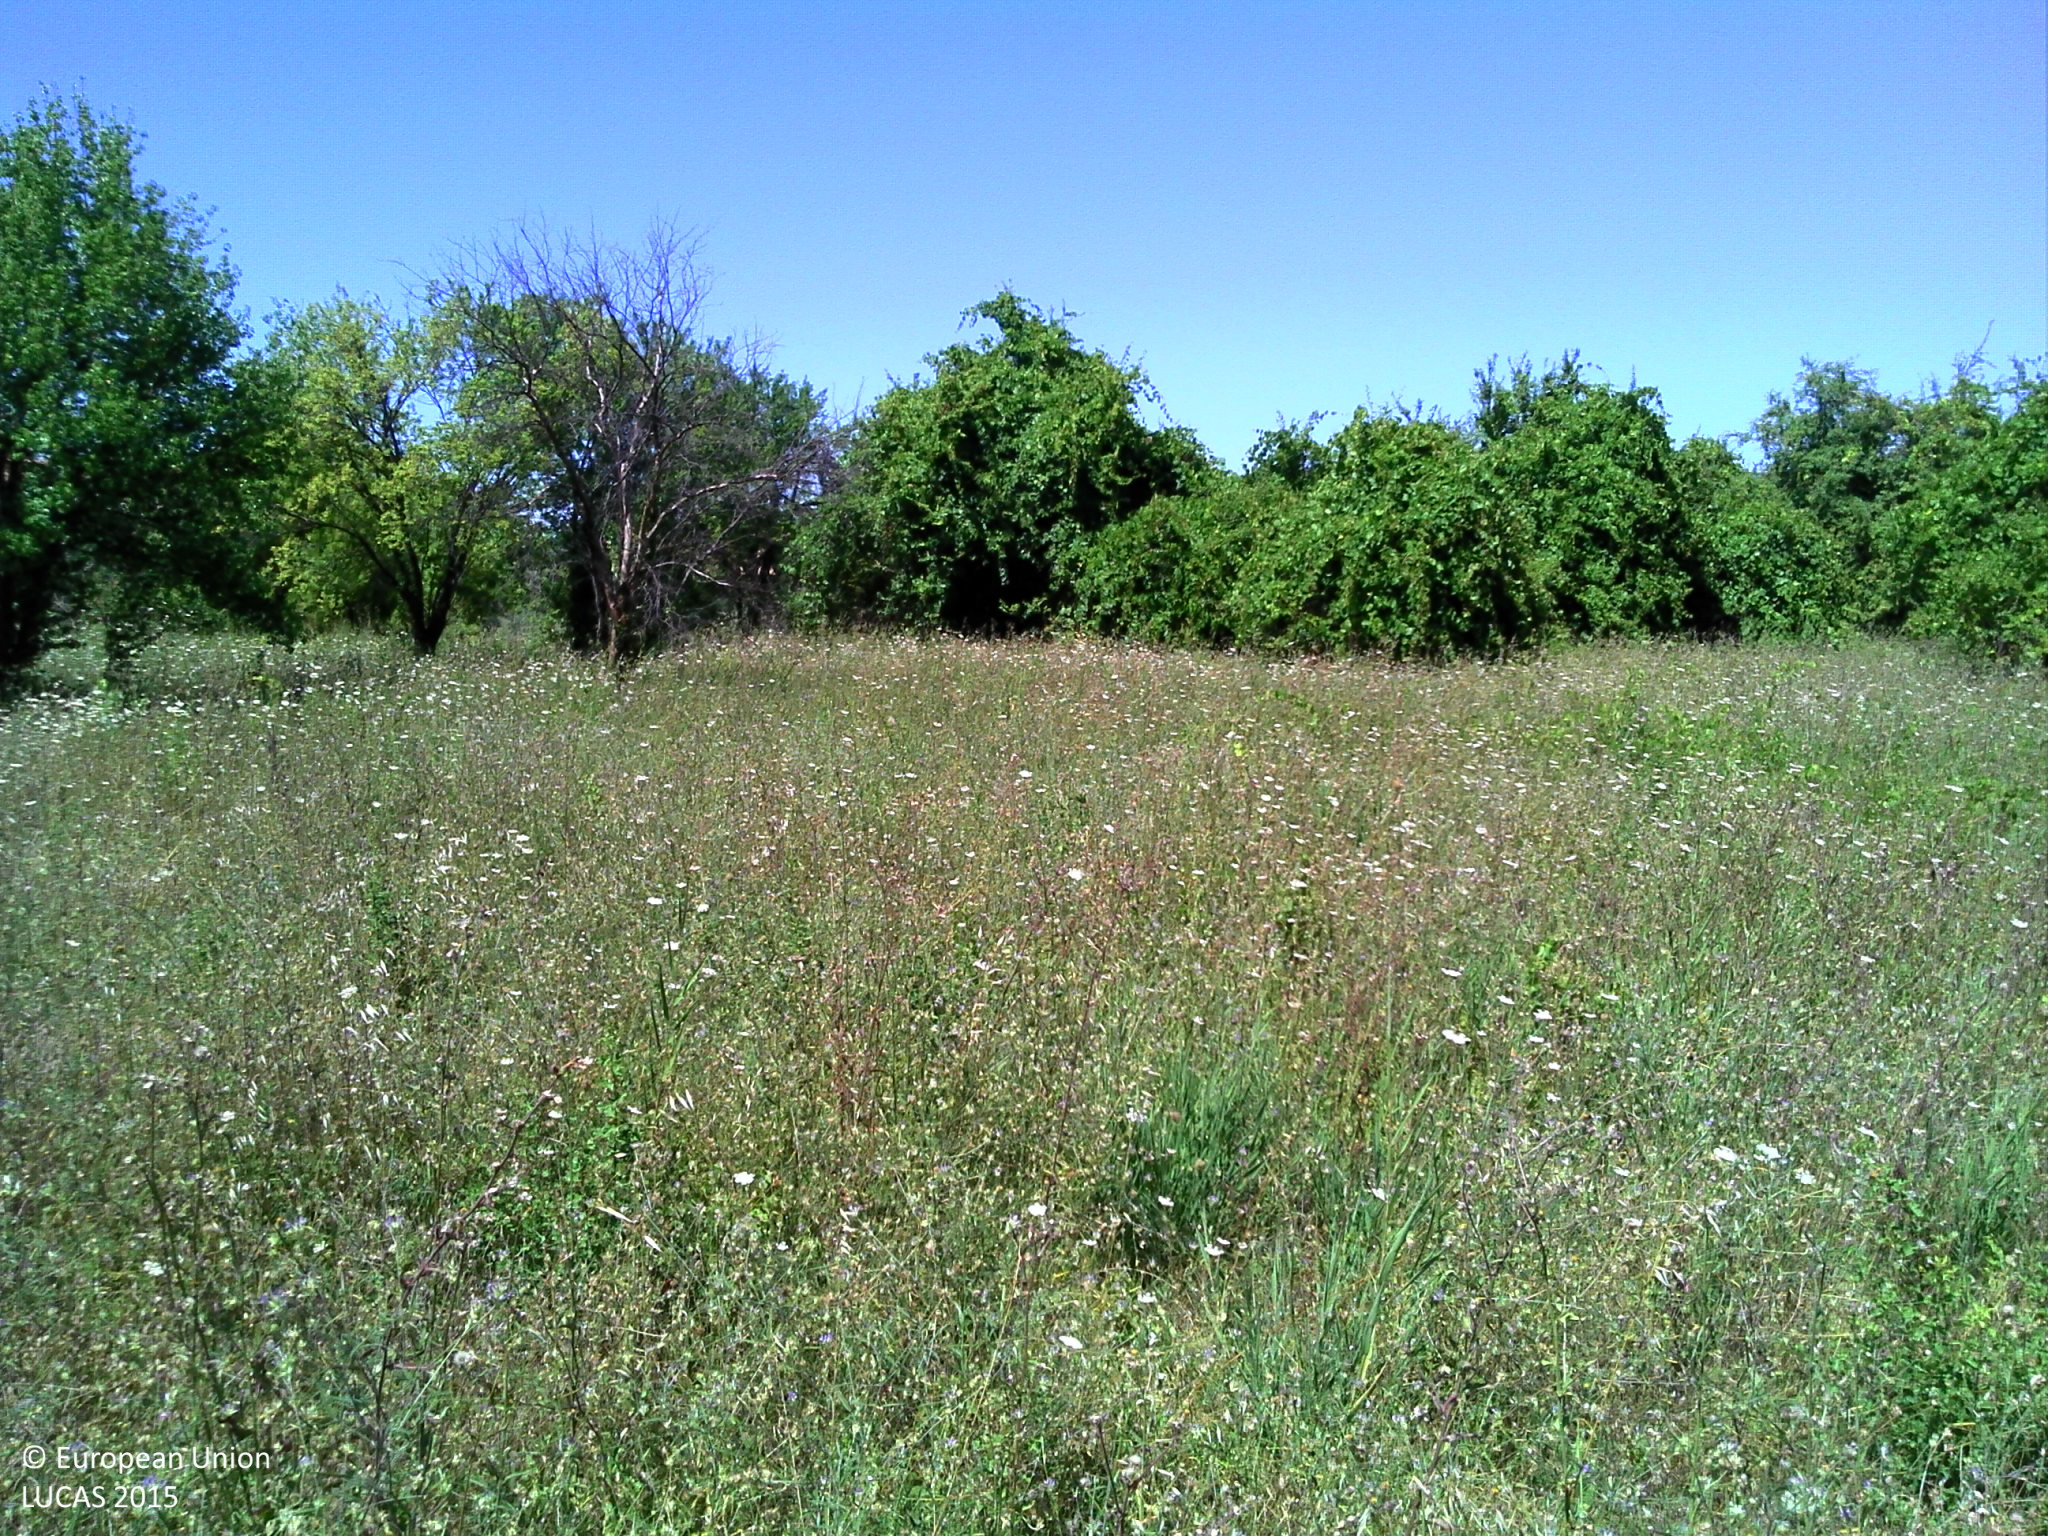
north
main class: Grassland
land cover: Grassland with sparse tree/shrub cover
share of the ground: > 75 %
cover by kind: herbaceous plants 90 %, broadleaved forest trees 5 %, shrubs 5 %
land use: Semi-natural and natural areas not in use
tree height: < 5 m
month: July
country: FR
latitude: 43.8563
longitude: 5.1196
